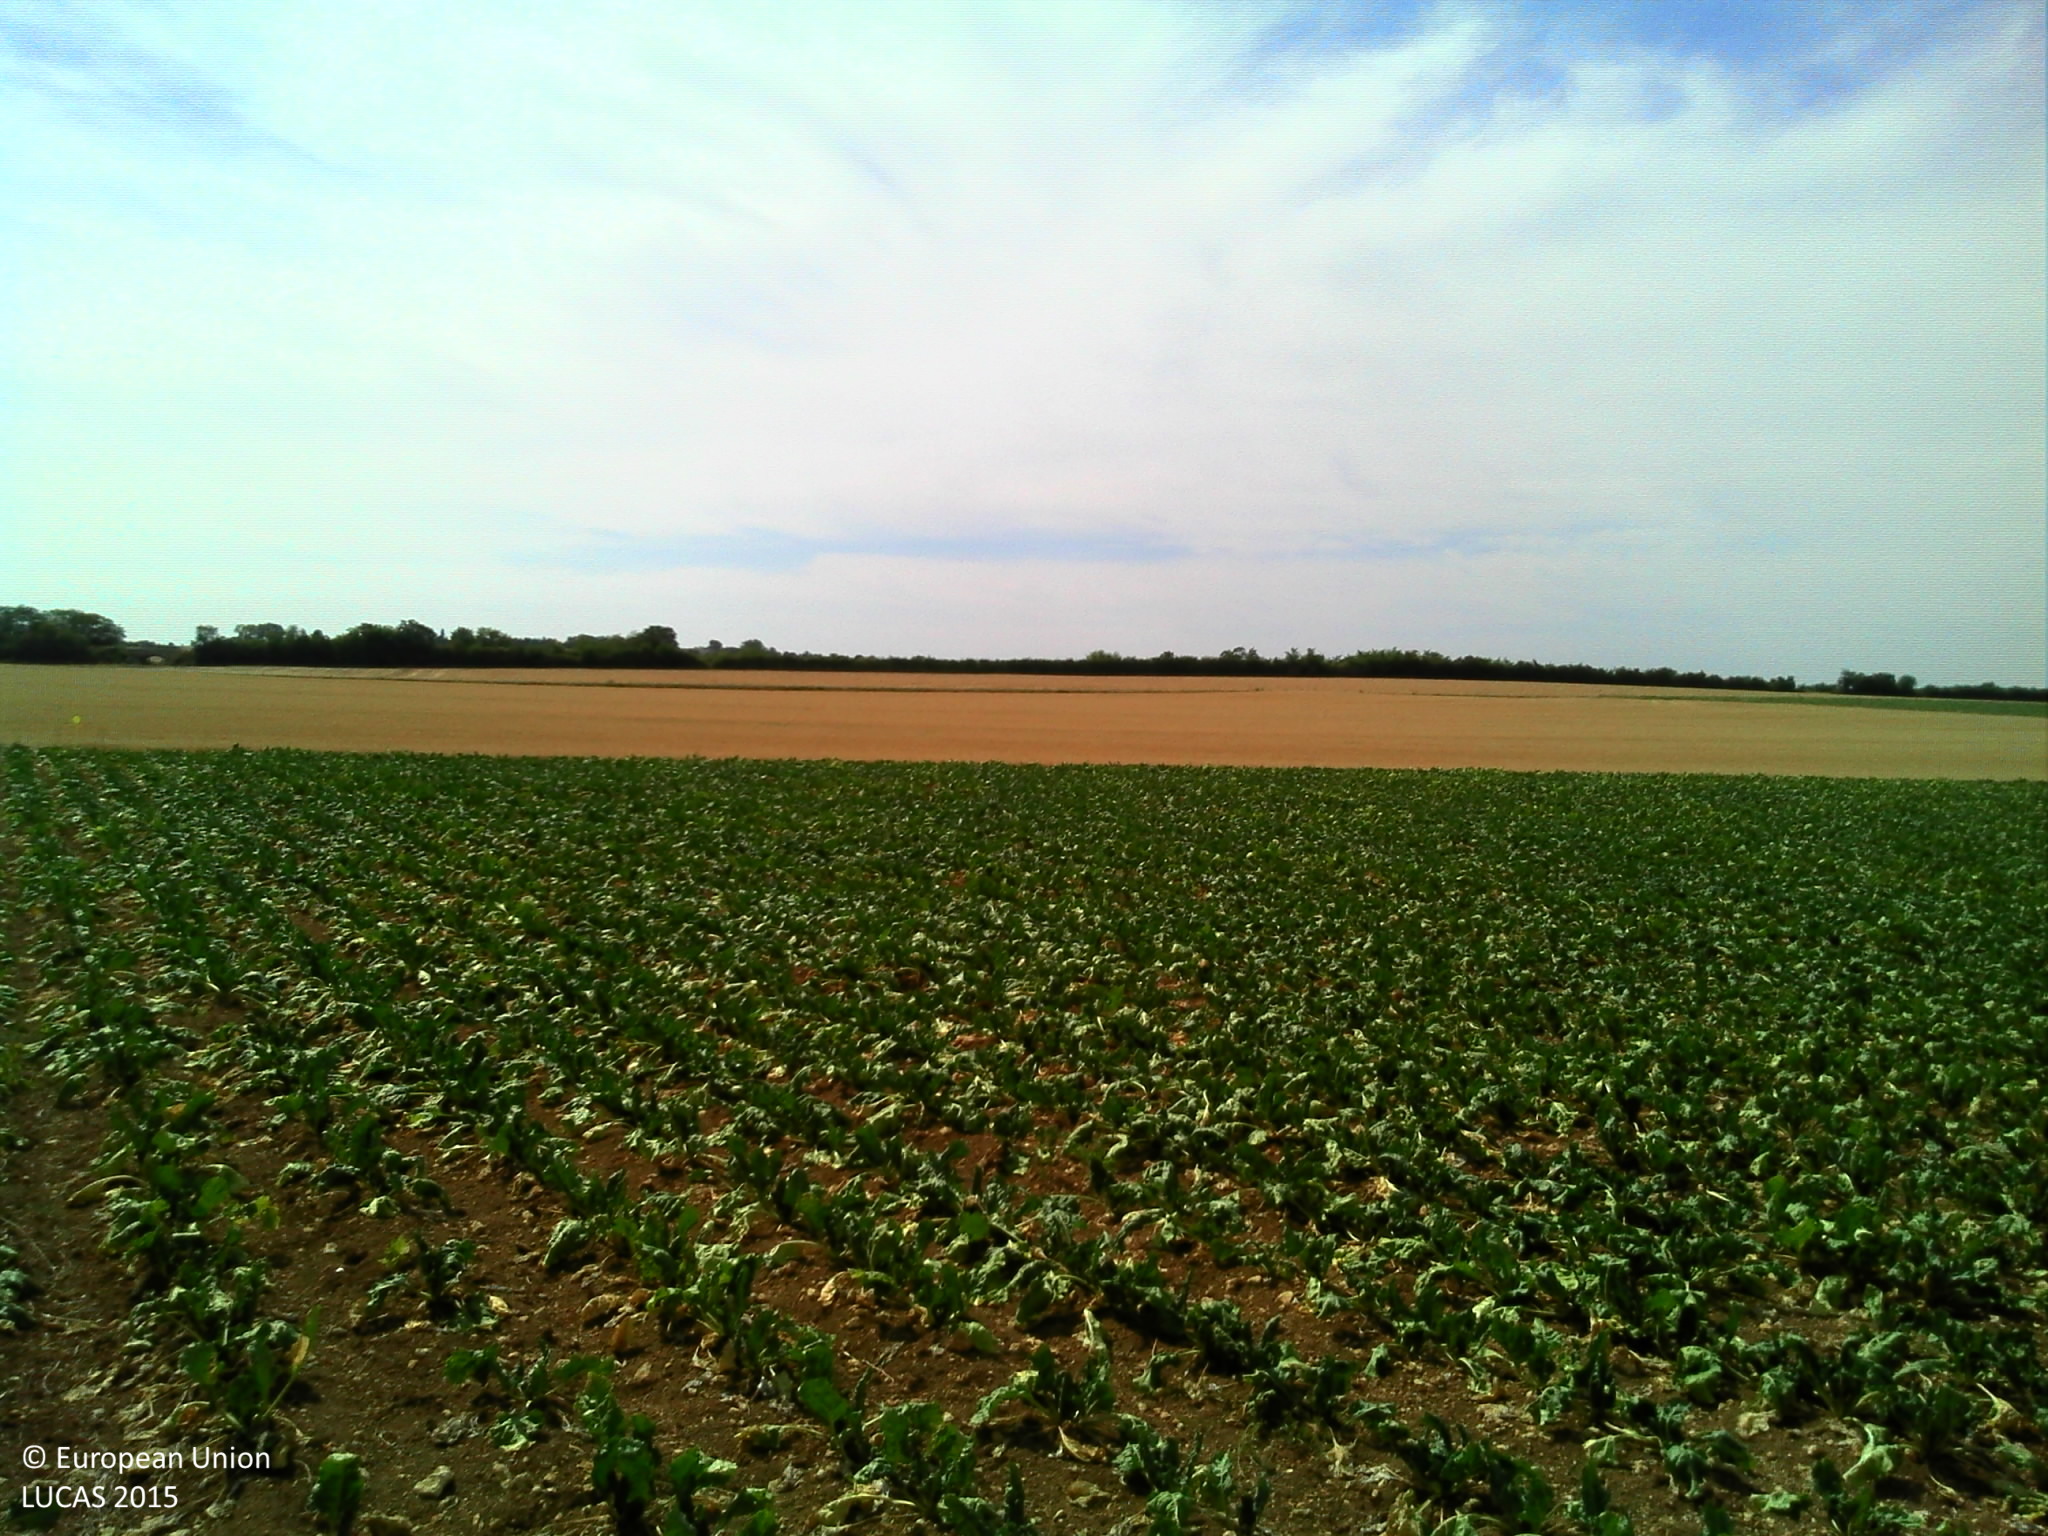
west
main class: Cropland
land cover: Sugar beet
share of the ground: > 75 %
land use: Agriculture (excluding fallow land and kitchen gardens)
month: August
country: FR
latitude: 48.1649
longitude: 2.4740
